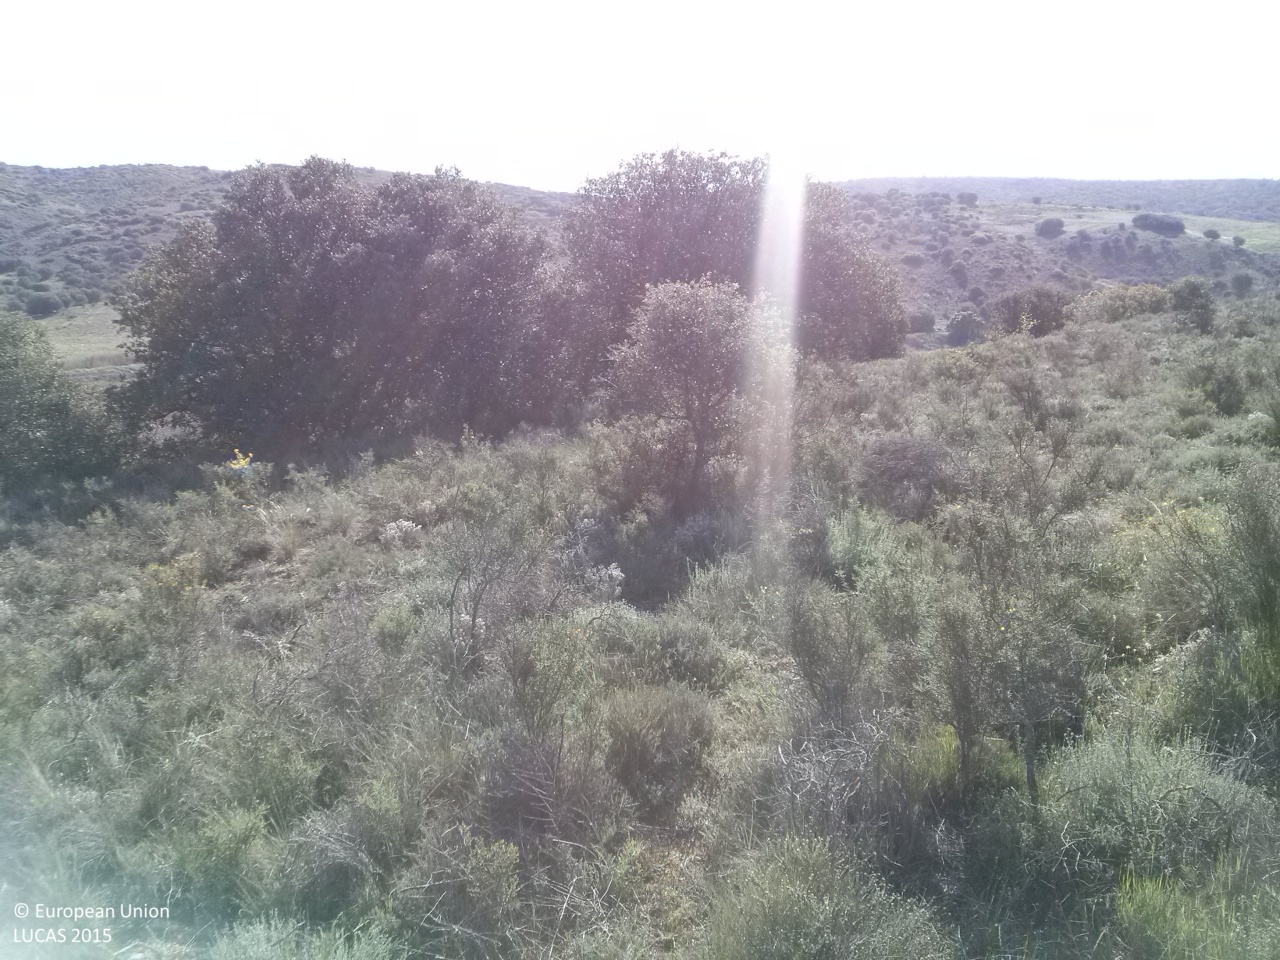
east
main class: Woodland
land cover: Broadleaved woodland
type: broadleaved evergreen forest
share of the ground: 10 - 25 %
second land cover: Shrubland without tree cover
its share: 50 - 75 %
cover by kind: shrubs 60 %, herbaceous plants 25 %, broadleaved forest trees 15 %
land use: Forestry
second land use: Agriculture (excluding fallow land and kitchen gardens)
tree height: < 5 m
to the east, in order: Broadleaved woodland; Shrubland without tree cover; Broadleaved woodland; Rock outcrops; Paved roads, cycling and walking lanes; Grass margins; Groves; Abandoned hedges; Other bare soil; Grassland with sparse tree/shrub cover; Rivers and streams; Grassland with sparse tree/shrub cover; Other bare soil; Single bushes/trees
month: May
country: ES
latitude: 39.8824
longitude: -2.8007
